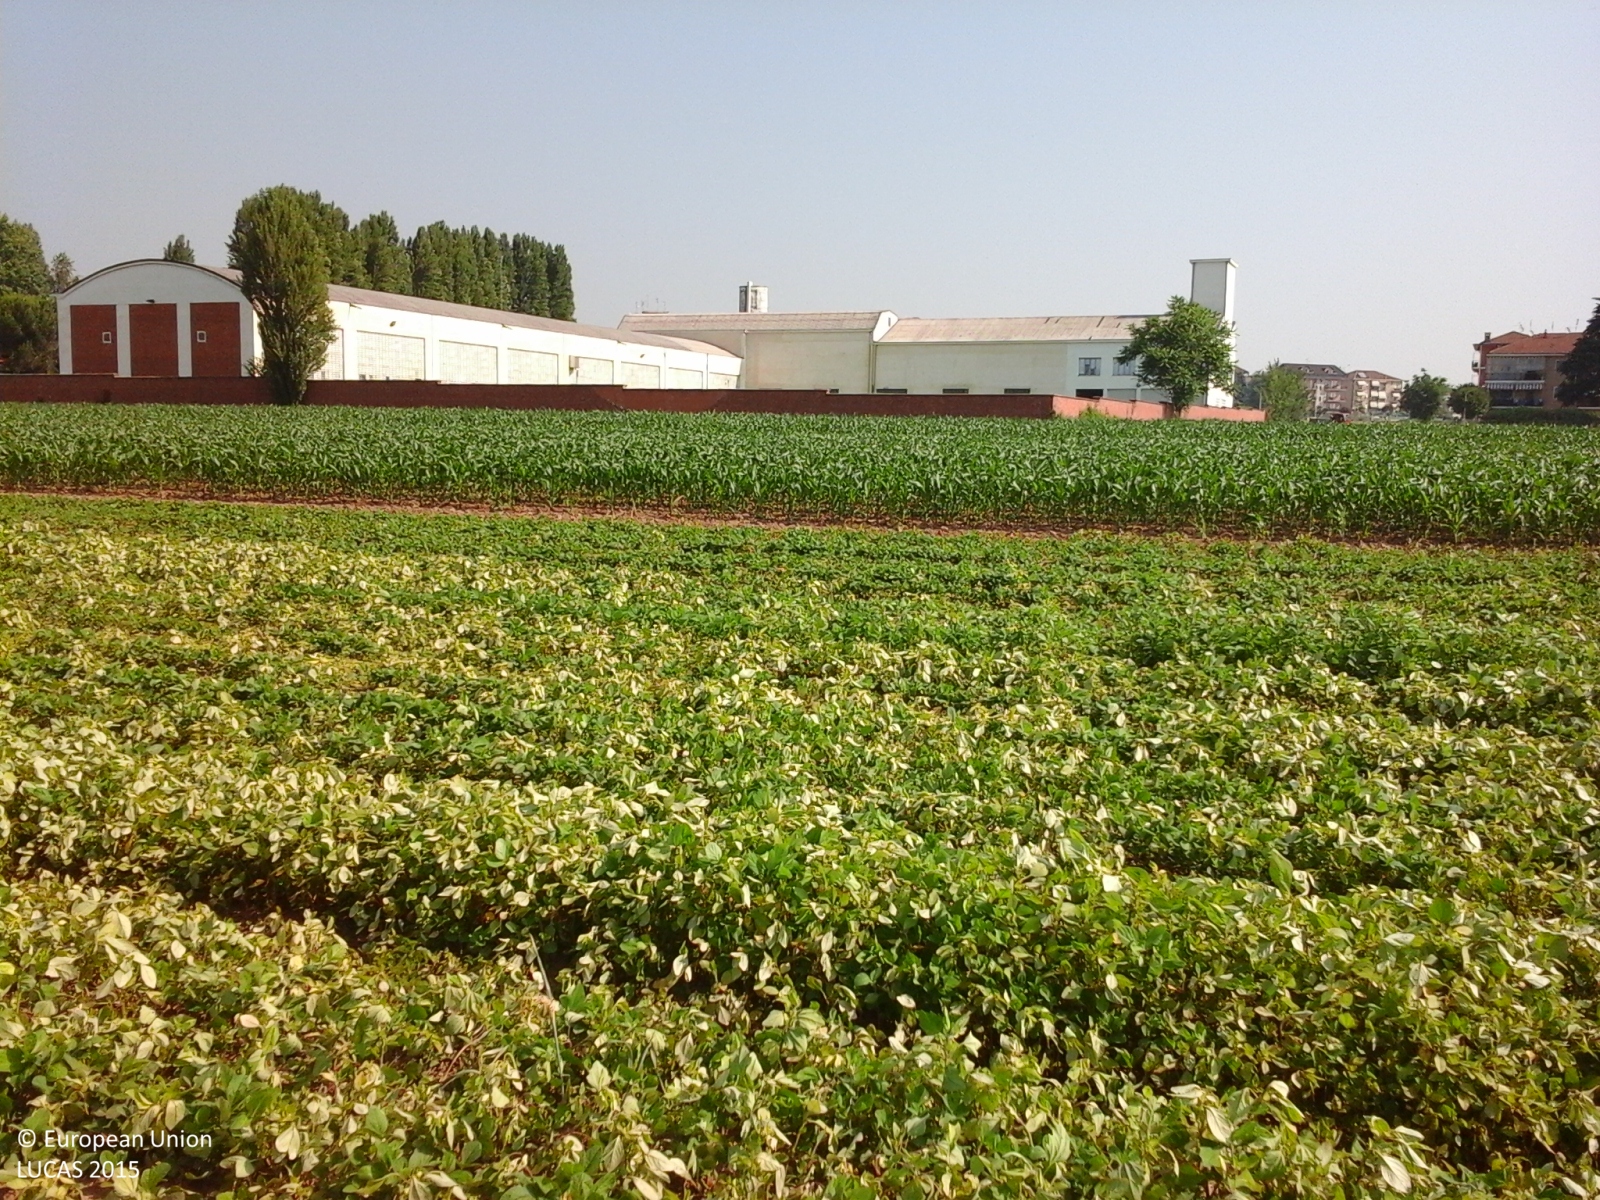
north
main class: Cropland
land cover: Soya
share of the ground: 50 - 75 %
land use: Agriculture (excluding fallow land and kitchen gardens)
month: June
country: IT
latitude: 44.9949
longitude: 7.8095
